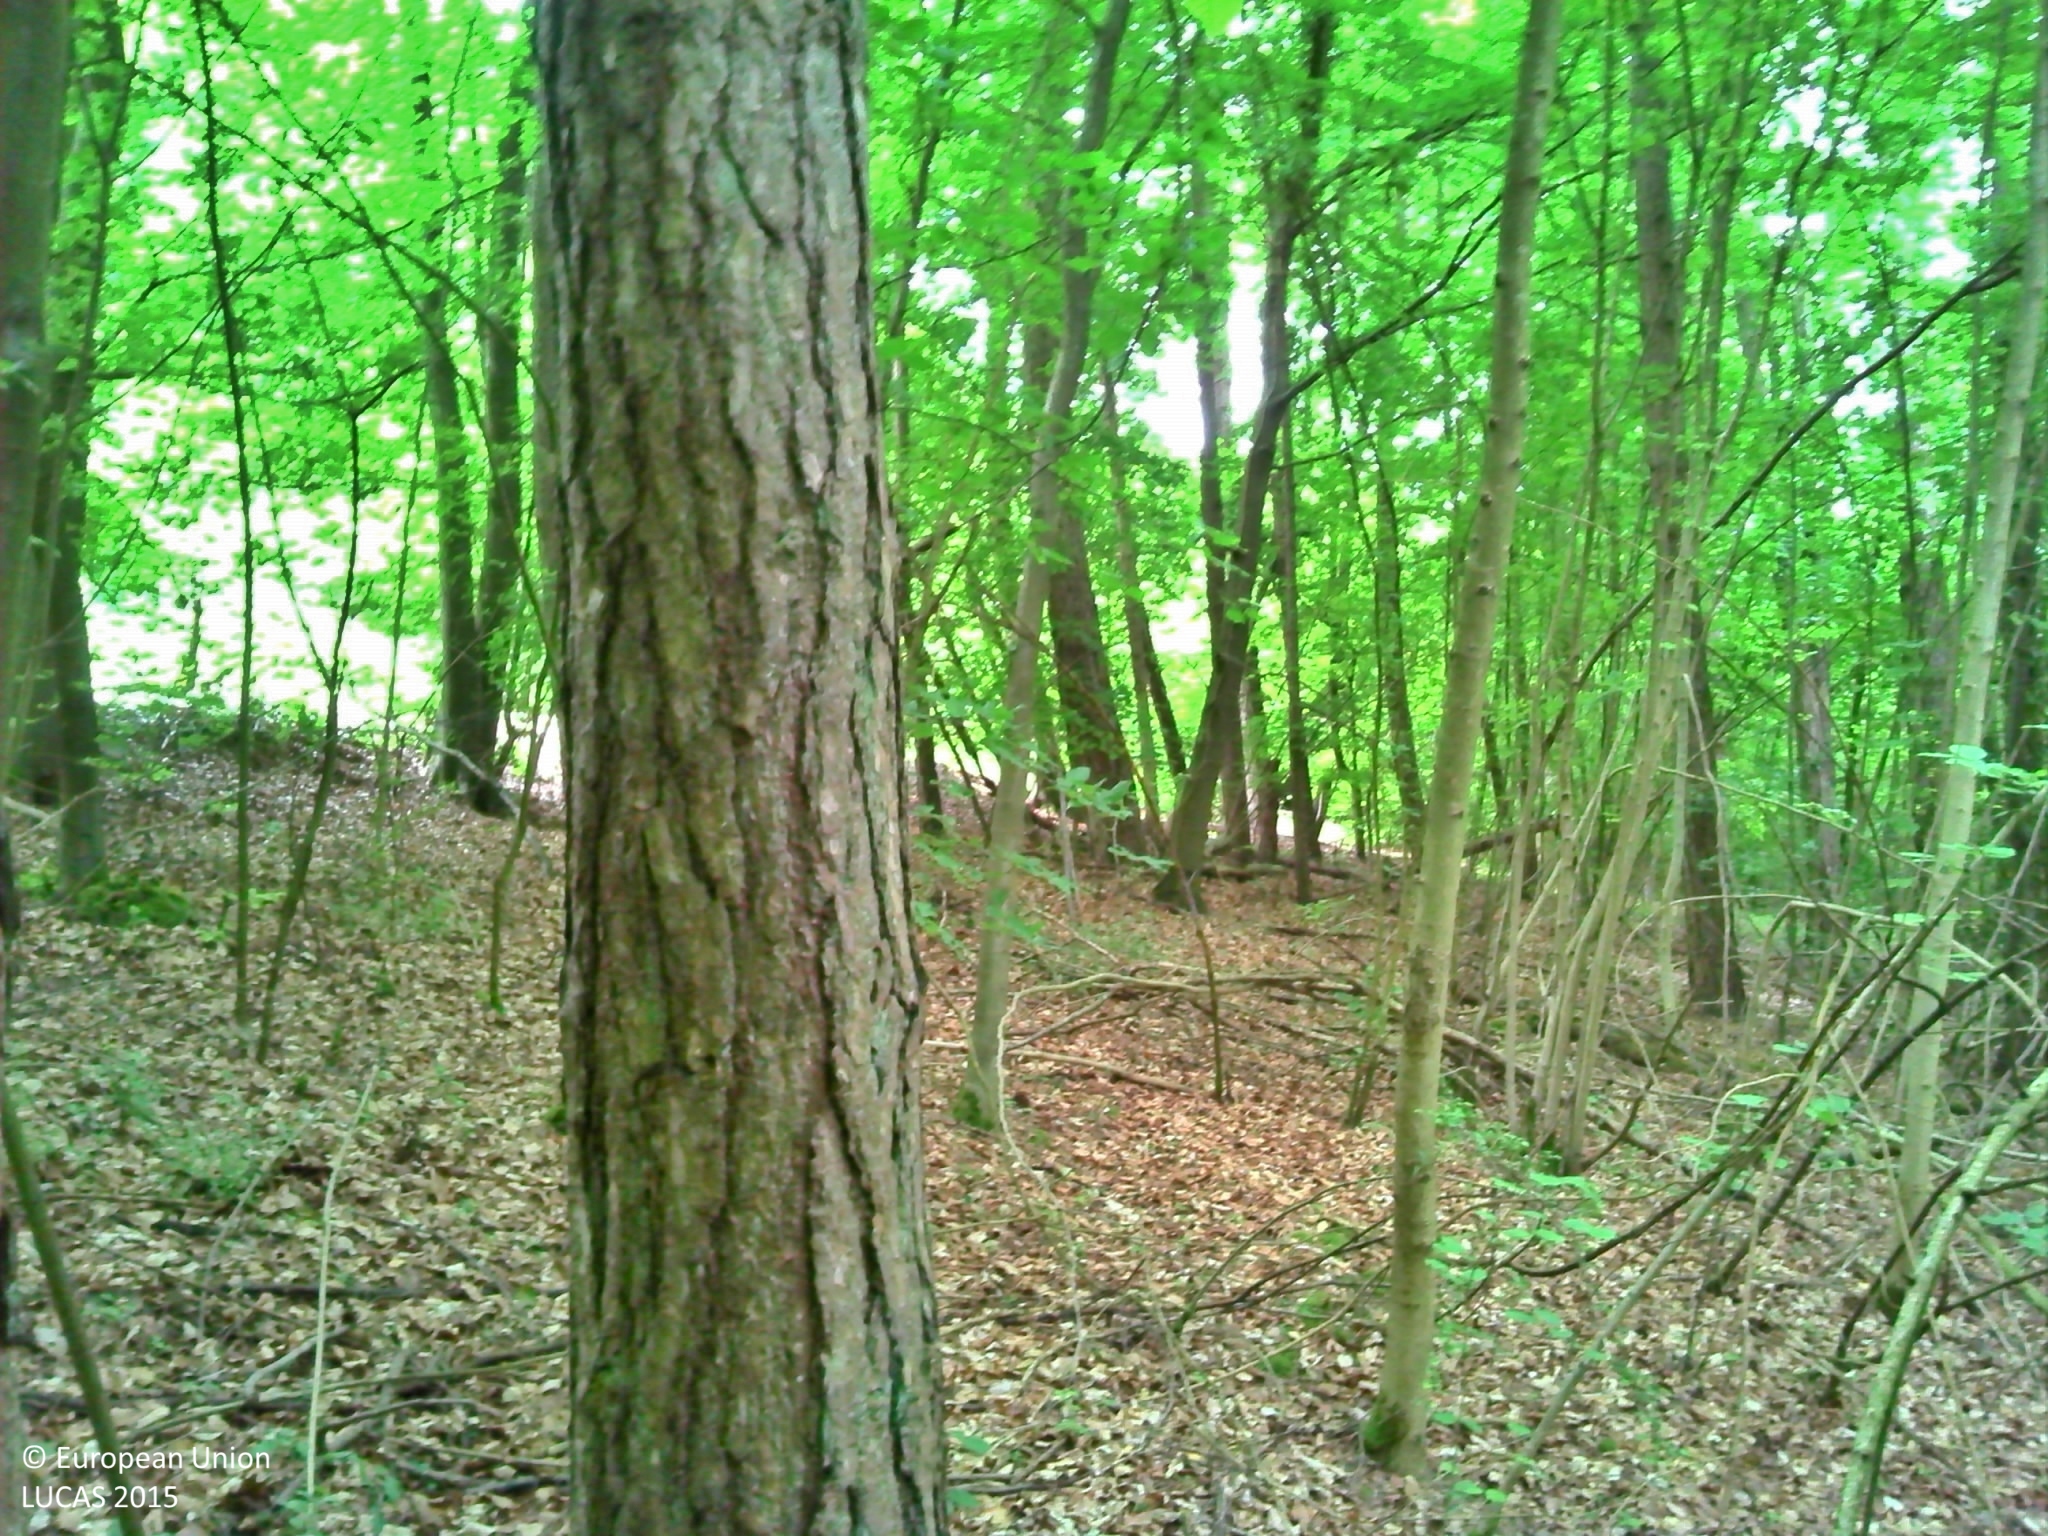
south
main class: Woodland
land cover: Broadleaved woodland
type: beech forest
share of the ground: > 75 %
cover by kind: broadleaved forest trees 85 %, herbaceous plants 10 %, shrubs 5 %
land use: Forestry
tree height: > 5 m
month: June
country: FR
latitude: 49.5754
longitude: 2.2281
